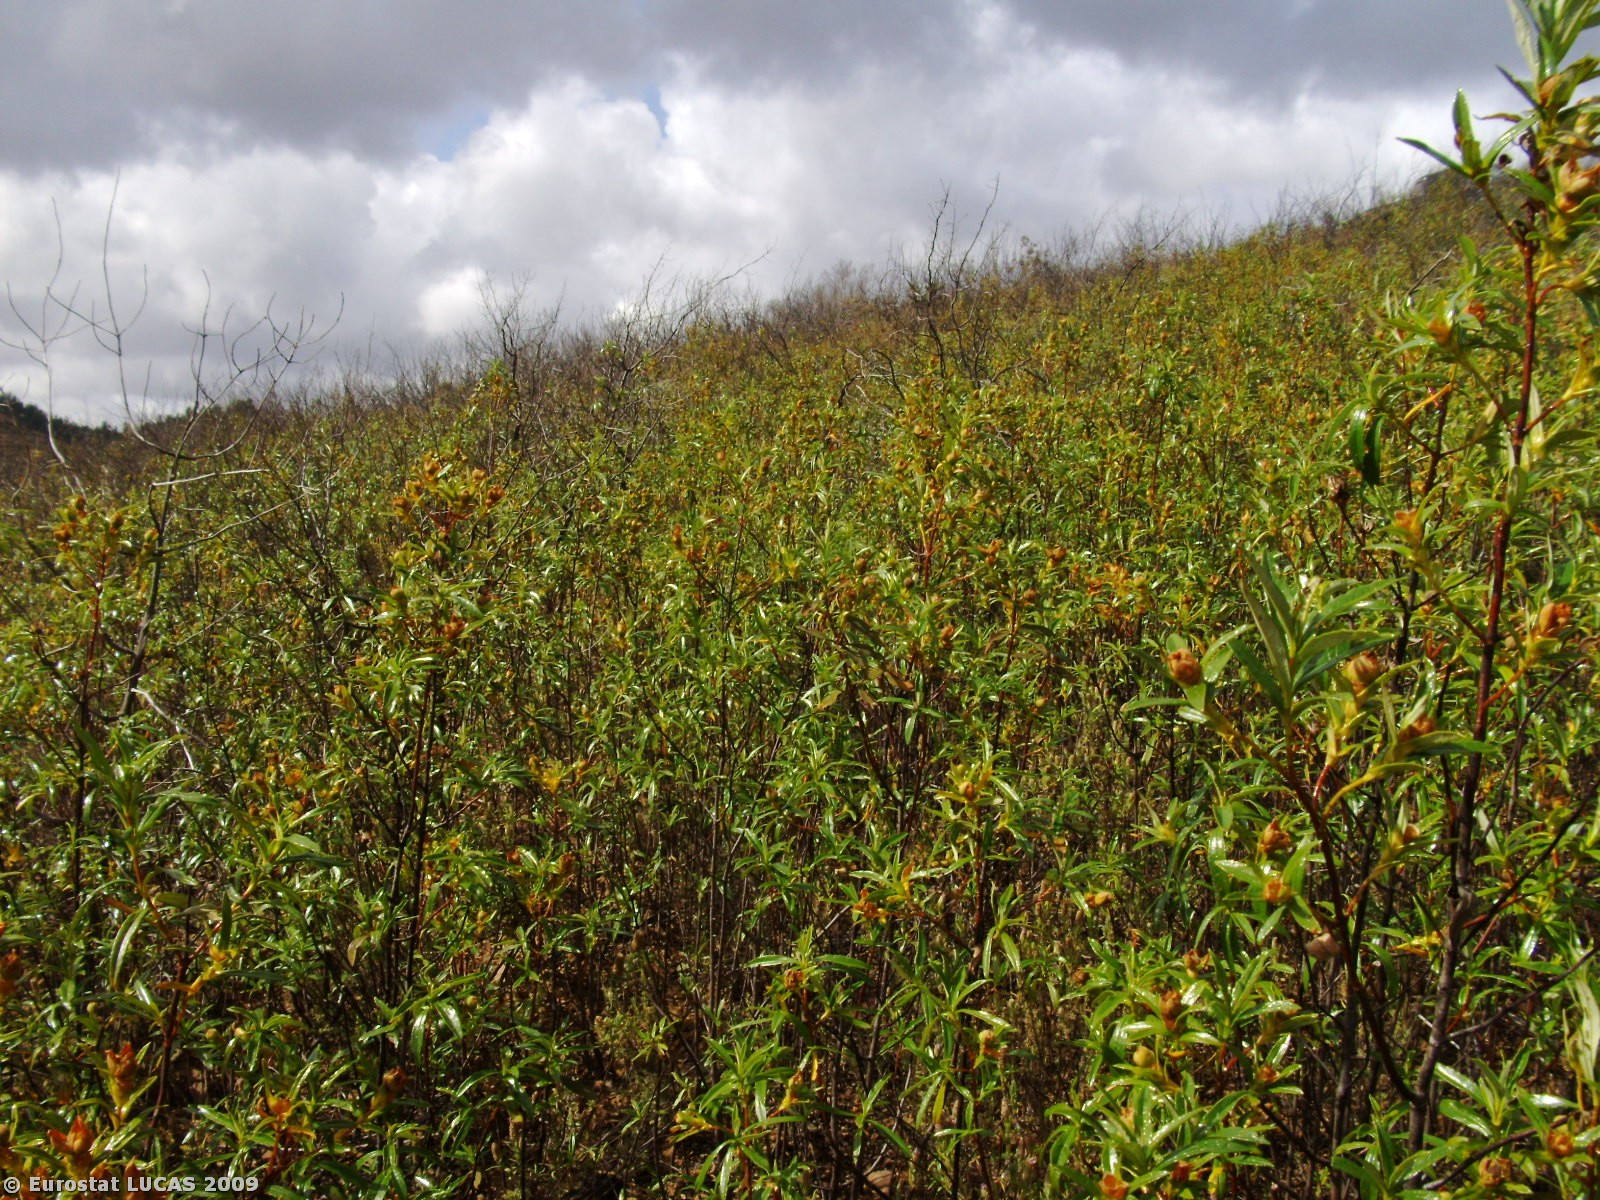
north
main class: Shrubland
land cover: Shrubland without tree cover
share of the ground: > 75 %
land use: Unused
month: June
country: PT
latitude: 37.2050
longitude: -8.7241
